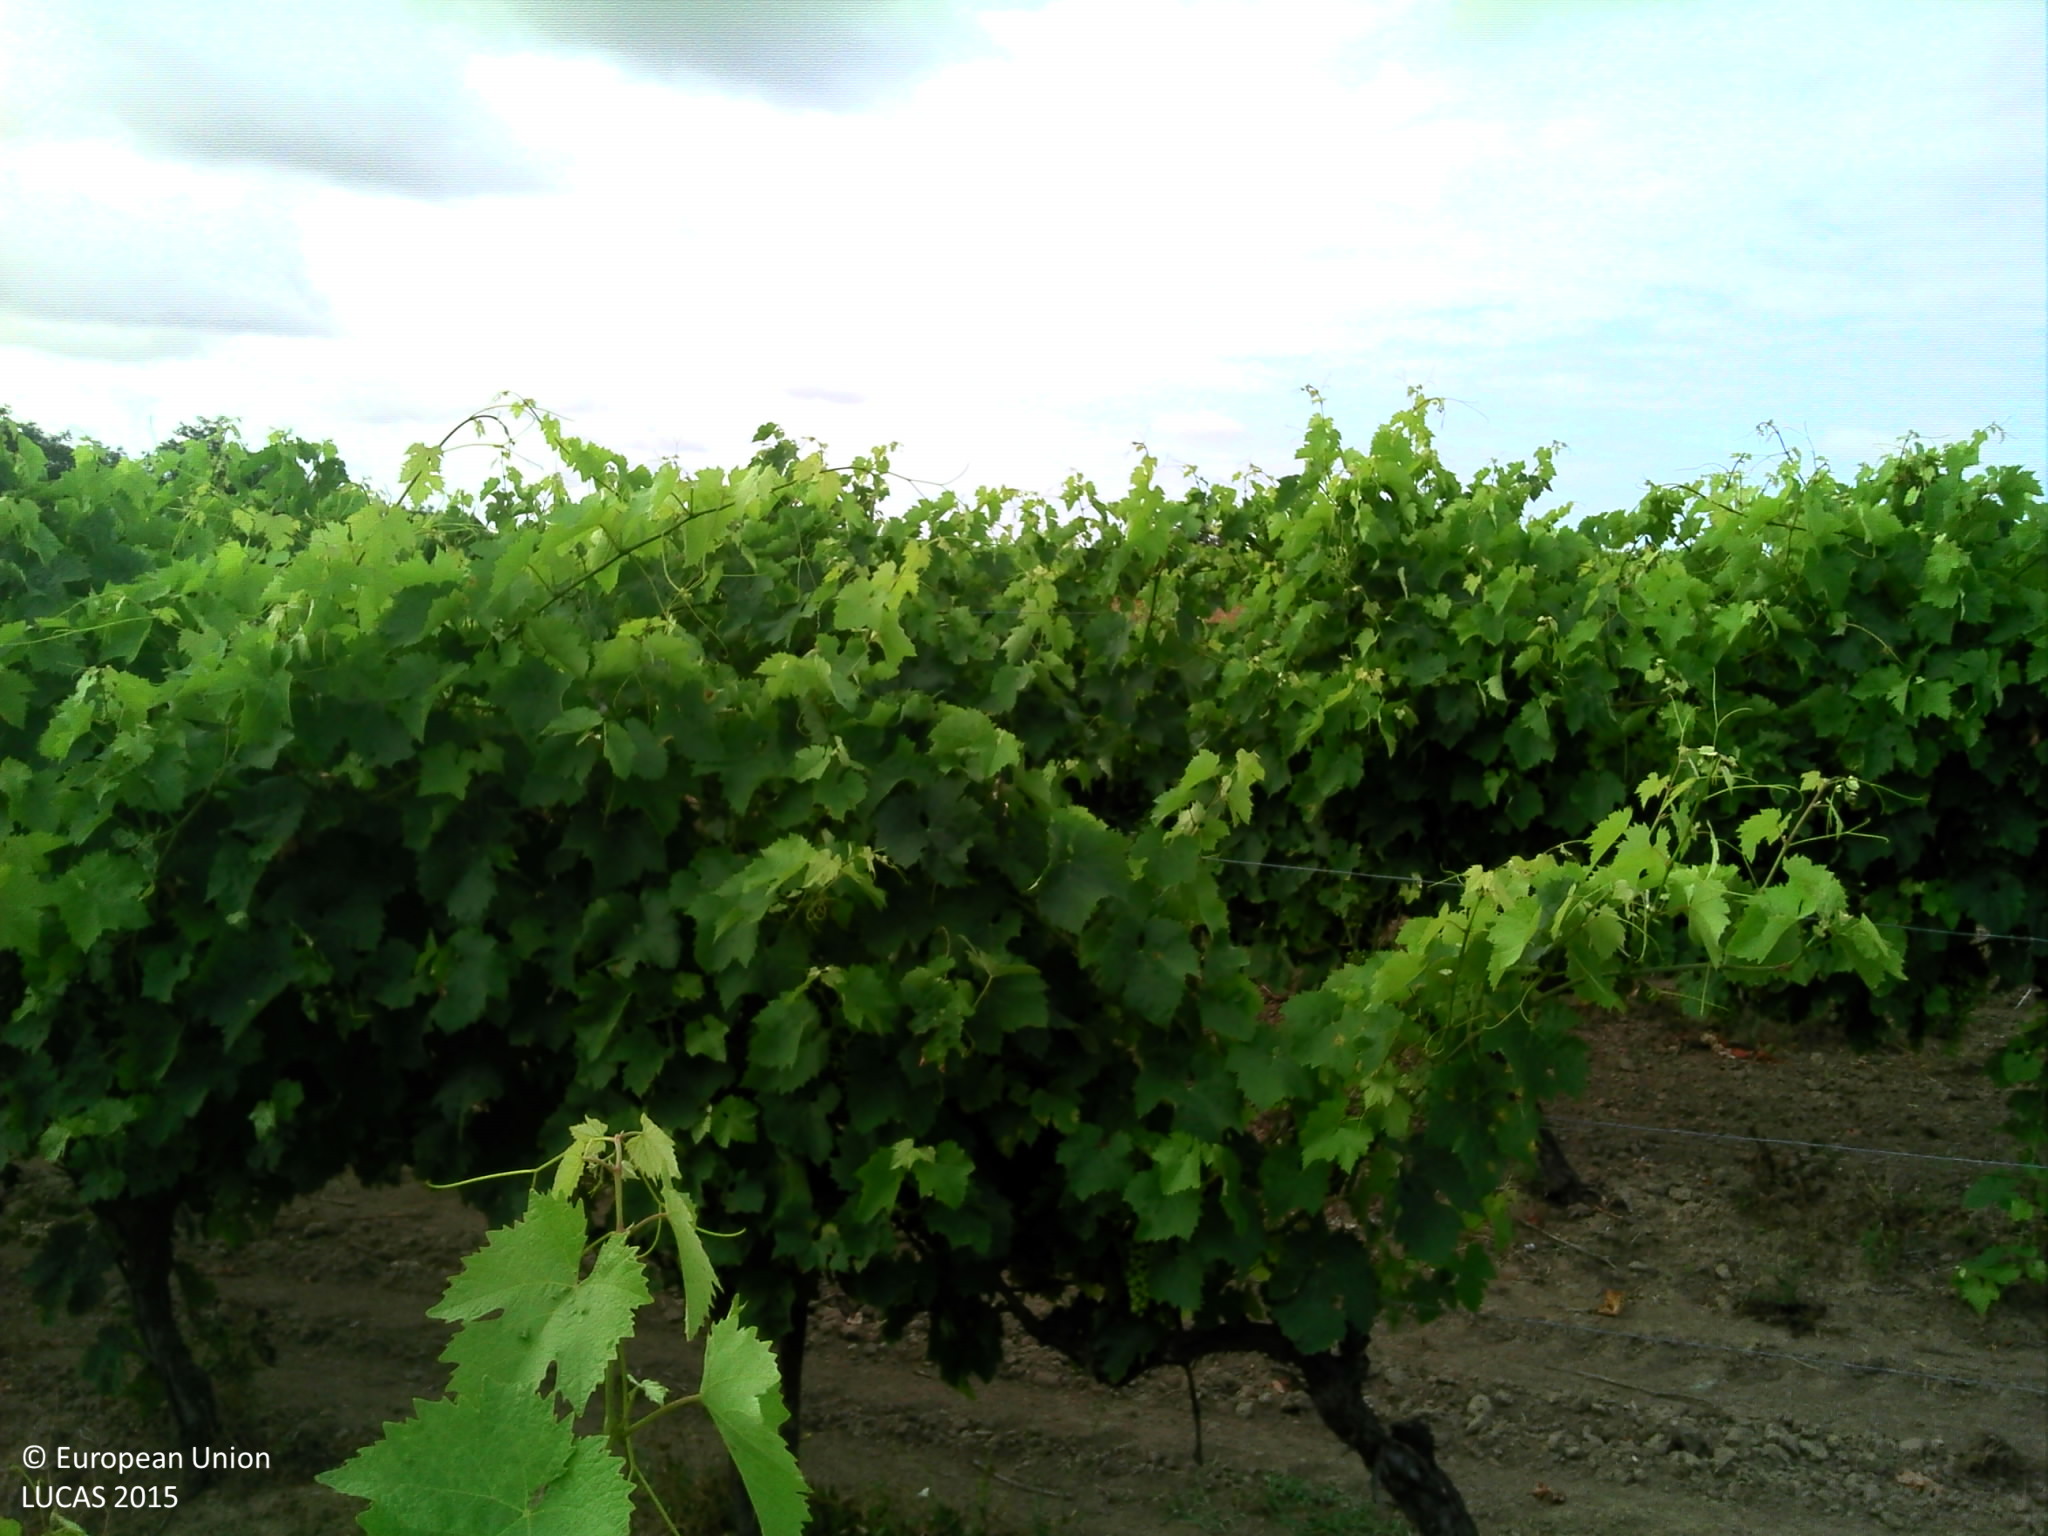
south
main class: Cropland
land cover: Vineyards
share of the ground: 50 - 75 %
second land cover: Other bare soil
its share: > 75 %
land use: Agriculture (excluding fallow land and kitchen gardens)
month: July
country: FR
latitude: 45.3301
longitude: -0.6248
